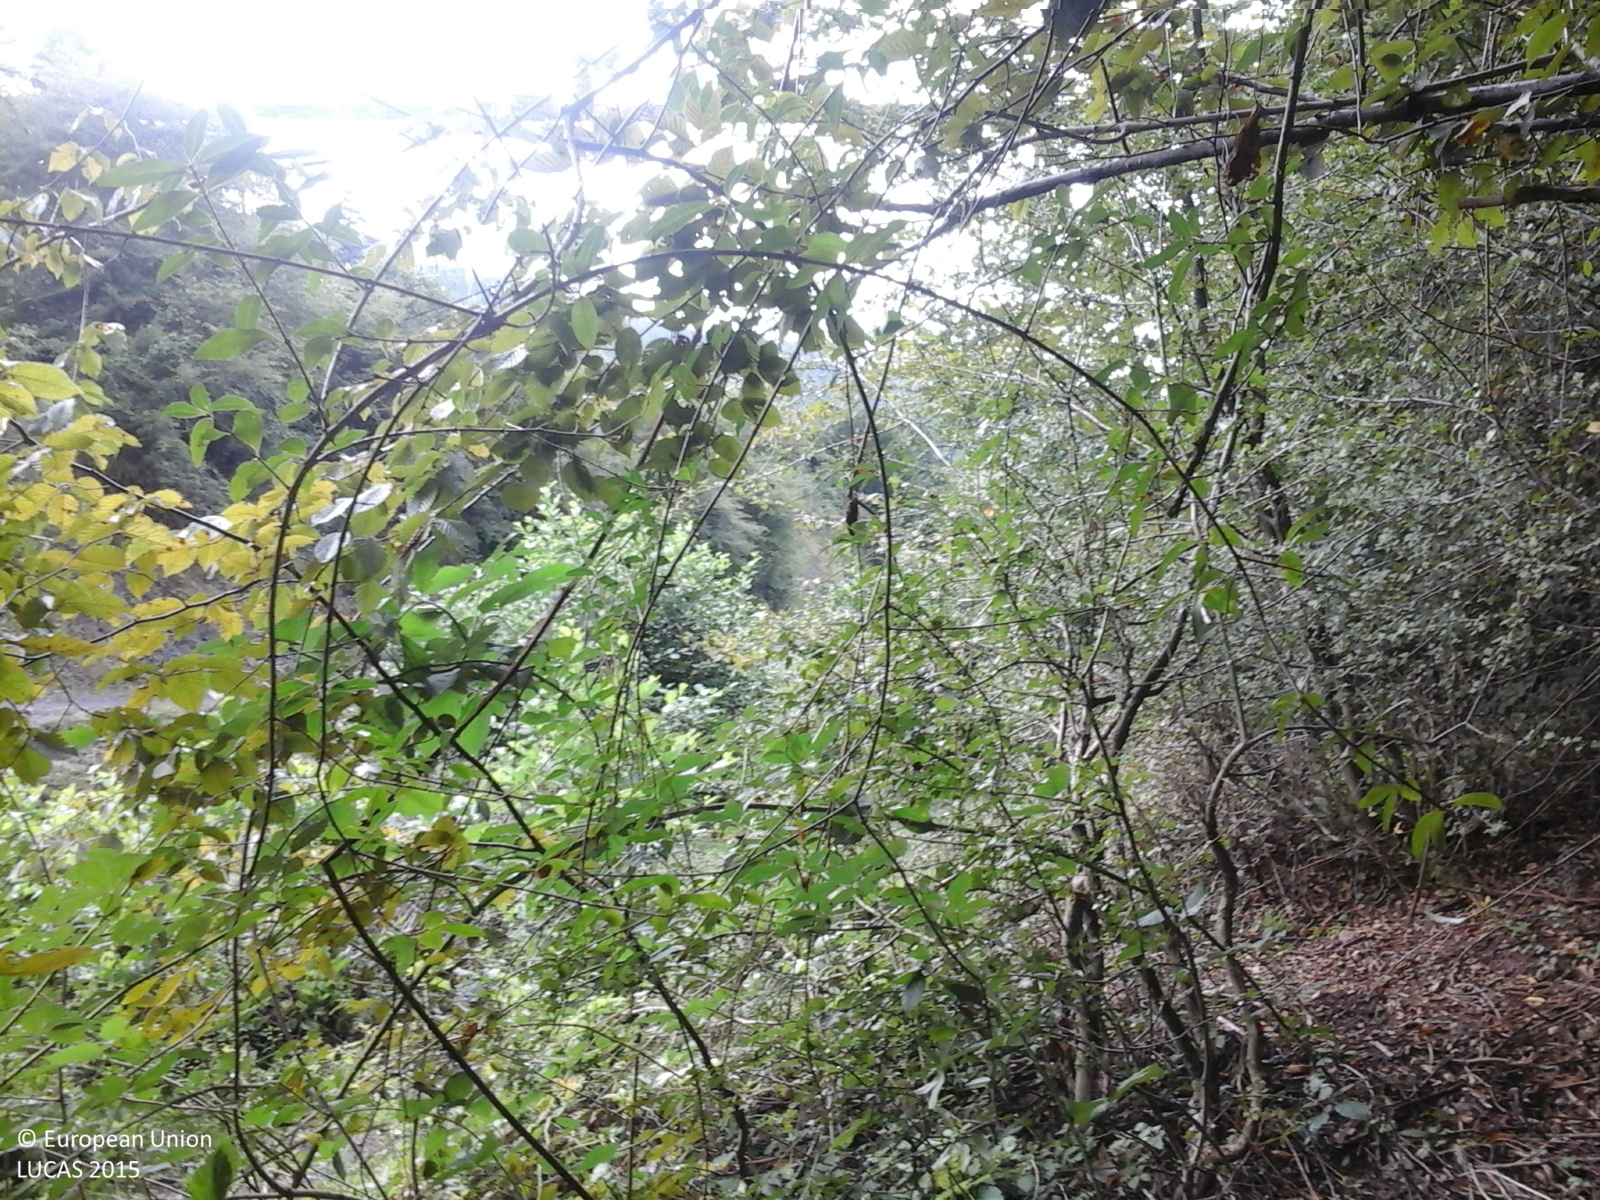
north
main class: Woodland
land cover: Broadleaved woodland
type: beech forest
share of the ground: > 75 %
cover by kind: broadleaved forest trees 100 %
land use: Forestry
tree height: > 5 m
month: August
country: RO
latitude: 45.2746
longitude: 21.9807
